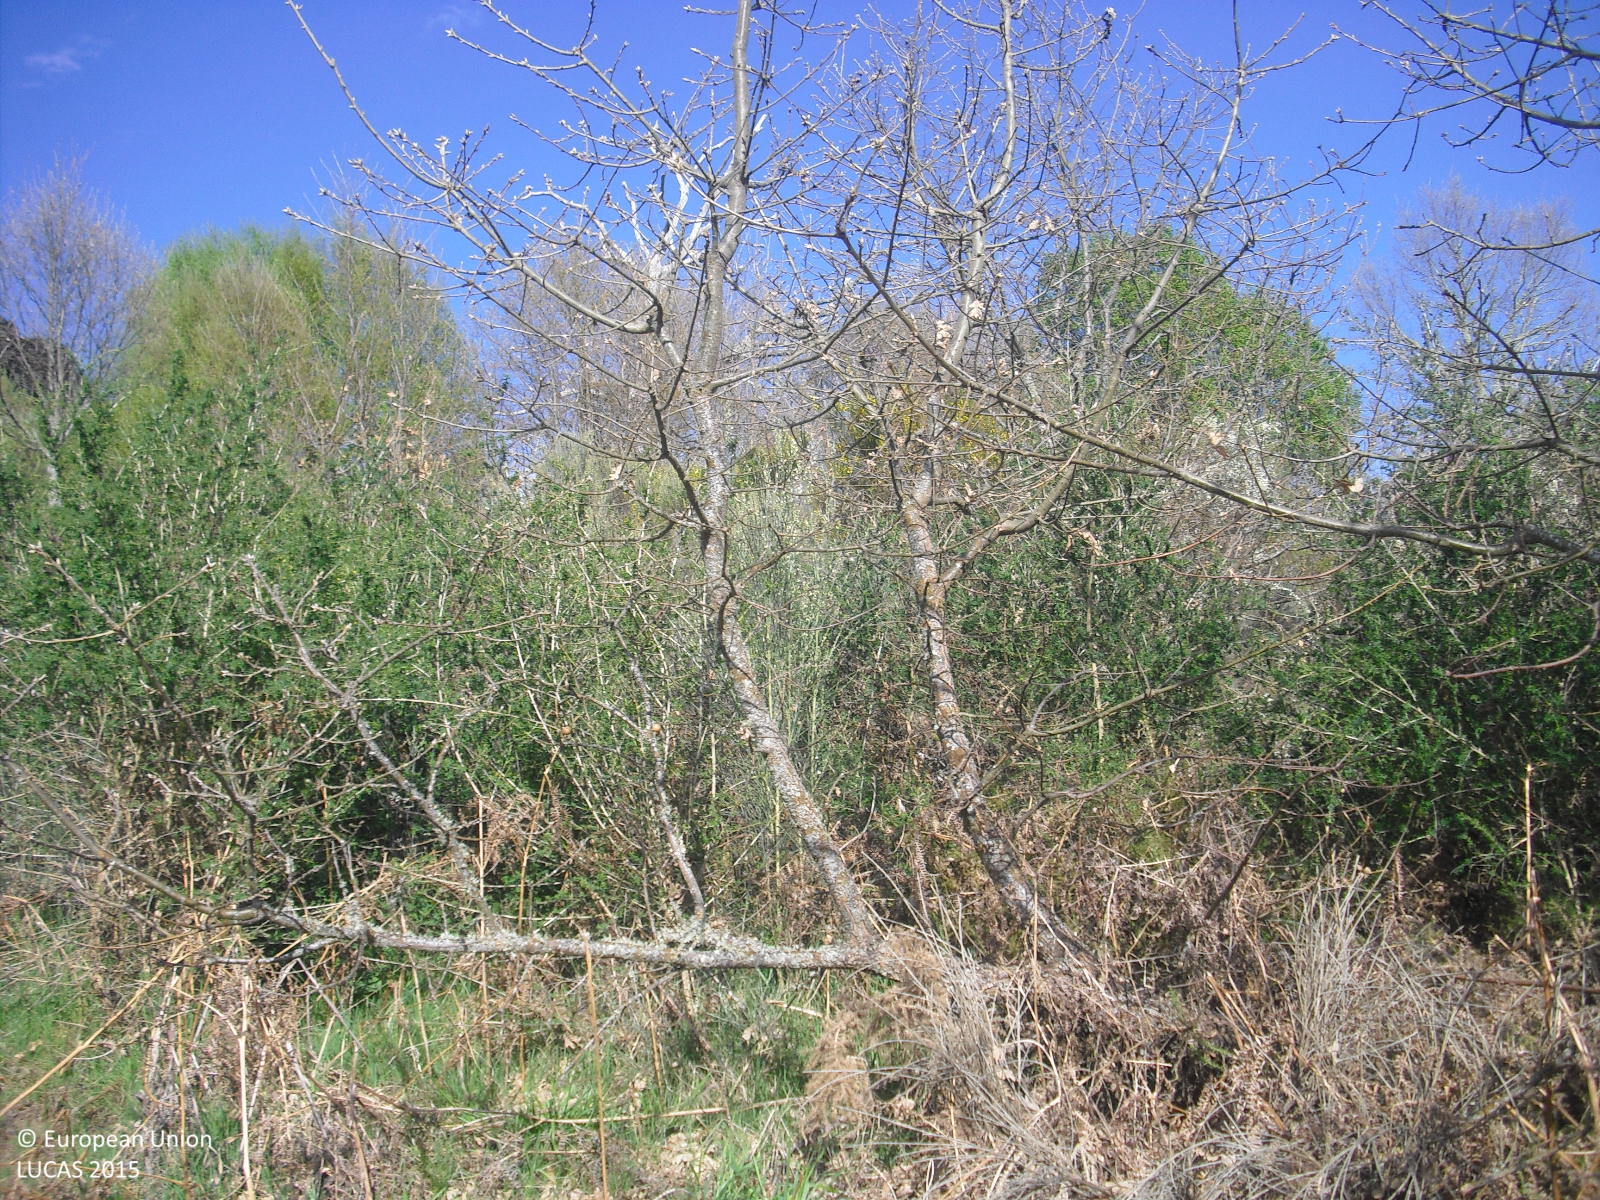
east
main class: Woodland
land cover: Broadleaved woodland
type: acidophilous oak and oak-birch forest
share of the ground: 25 - 50 %
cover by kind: shrubs 50 %, broadleaved forest trees 40 %, herbaceous plants 10 %
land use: Semi-natural and natural areas not in use
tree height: > 5 m
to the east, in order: Broadleaved woodland; Shrubland without tree cover; Shrubland with sparse tree cover; Tracks; Ditches and canals; Broadleaved woodland; Shrubland with sparse tree cover; Shrubland without tree cover; Pine dominated coniferous woodland
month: April
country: ES
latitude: 41.9193
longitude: -7.8559
